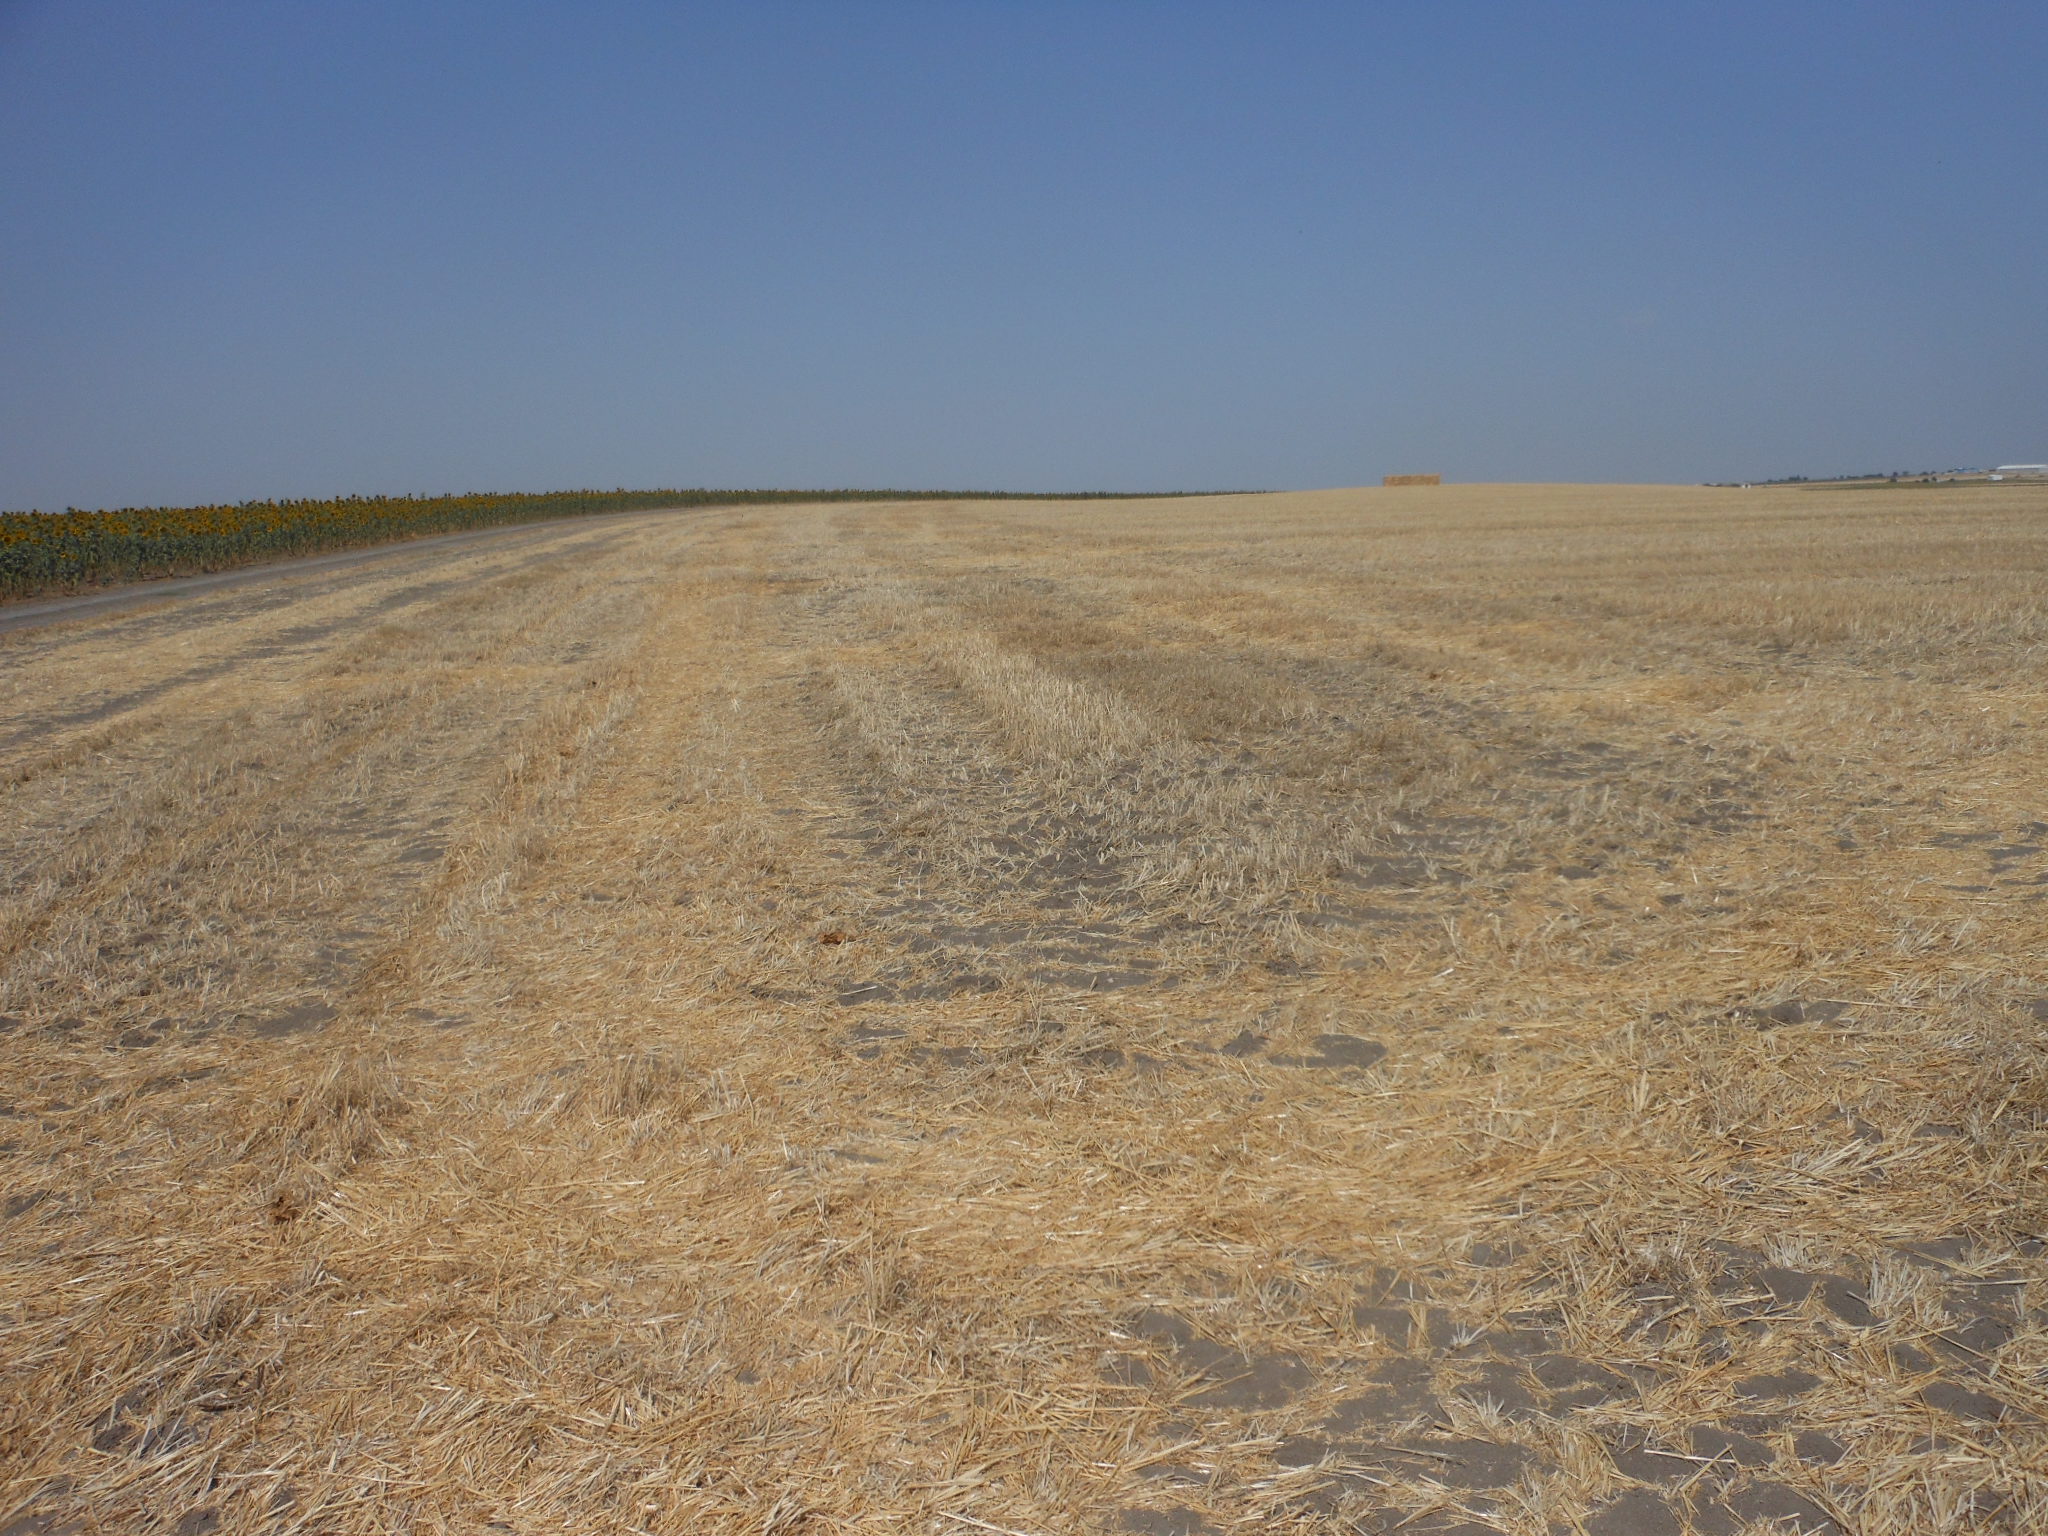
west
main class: Cropland
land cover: Durum wheat
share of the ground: < 10 %
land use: Agriculture (excluding fallow land and kitchen gardens)
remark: Harvested field
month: June
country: ES
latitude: 37.3937
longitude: -5.1355
